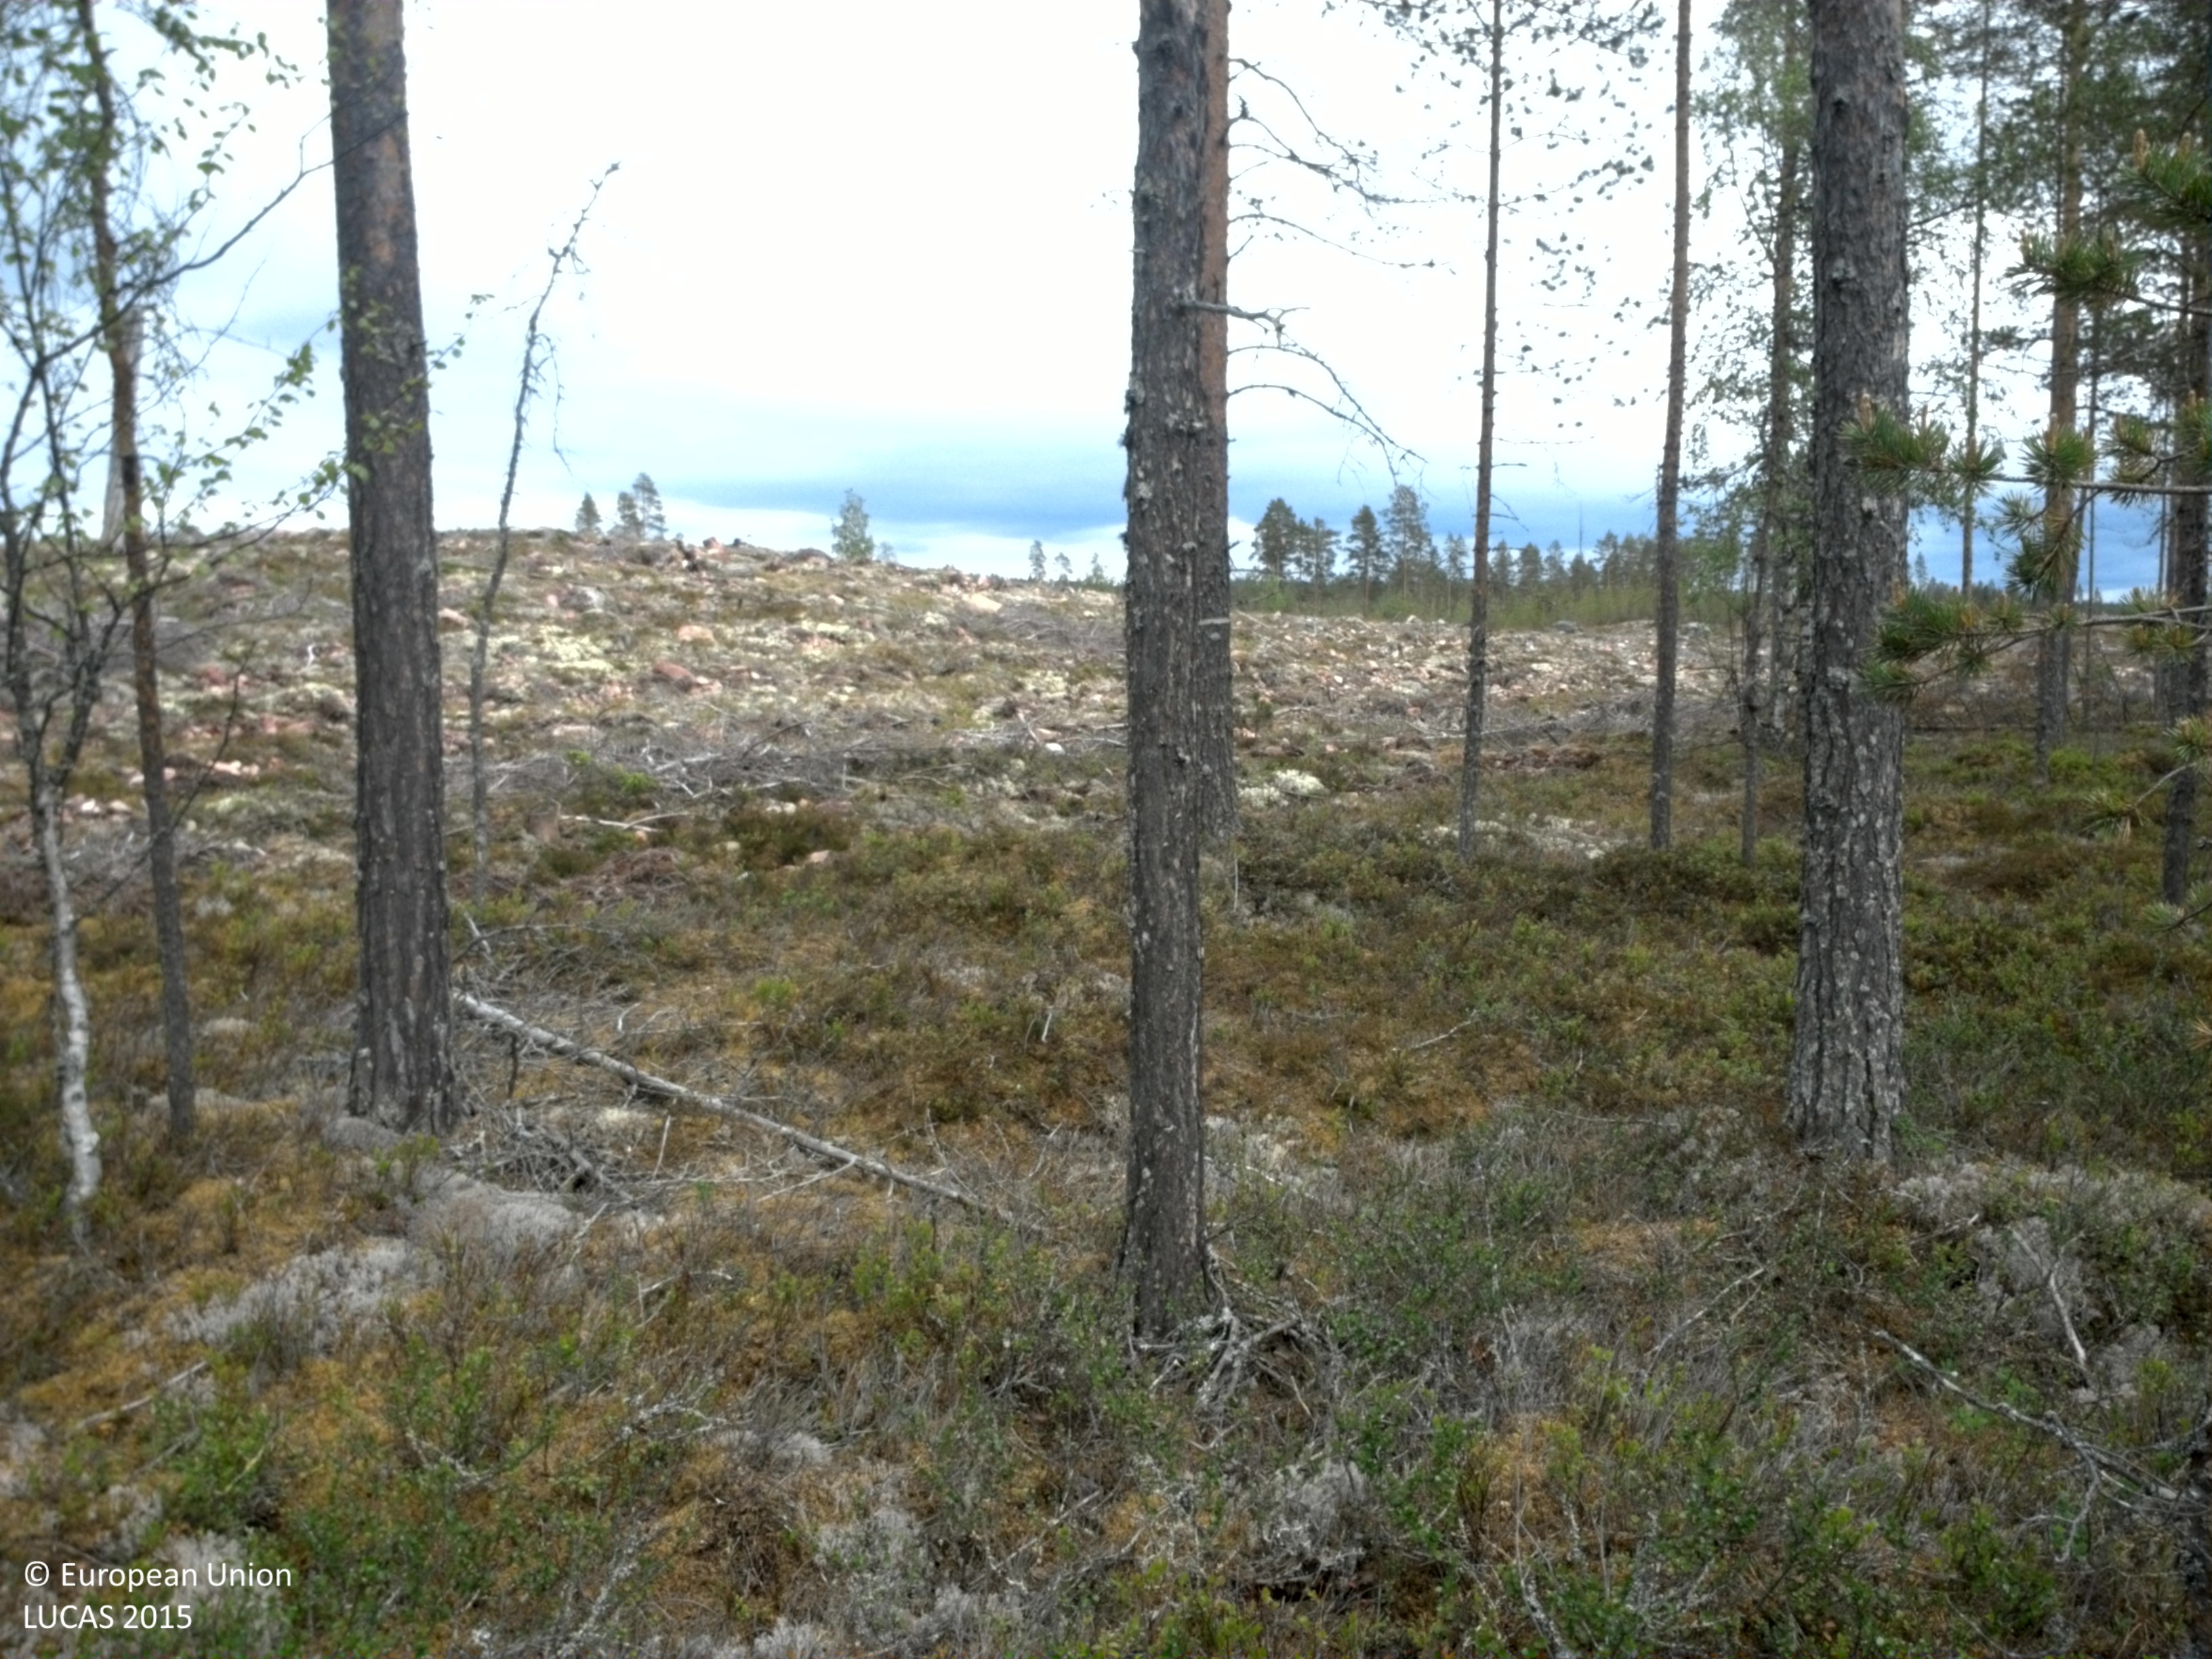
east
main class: Woodland
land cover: Pine dominated coniferous woodland
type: boreal forest
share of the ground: 50 - 75 %
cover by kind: coniferous forest trees 60 %, herbaceous plants 20 %, lichens and mosses 20 %
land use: Forestry
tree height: > 5 m
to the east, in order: Pine dominated coniferous woodland; Other bare soil; Paved roads, cycling and walking lanes; Pine dominated coniferous woodland
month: June
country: SE
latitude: 61.3067
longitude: 13.5911
